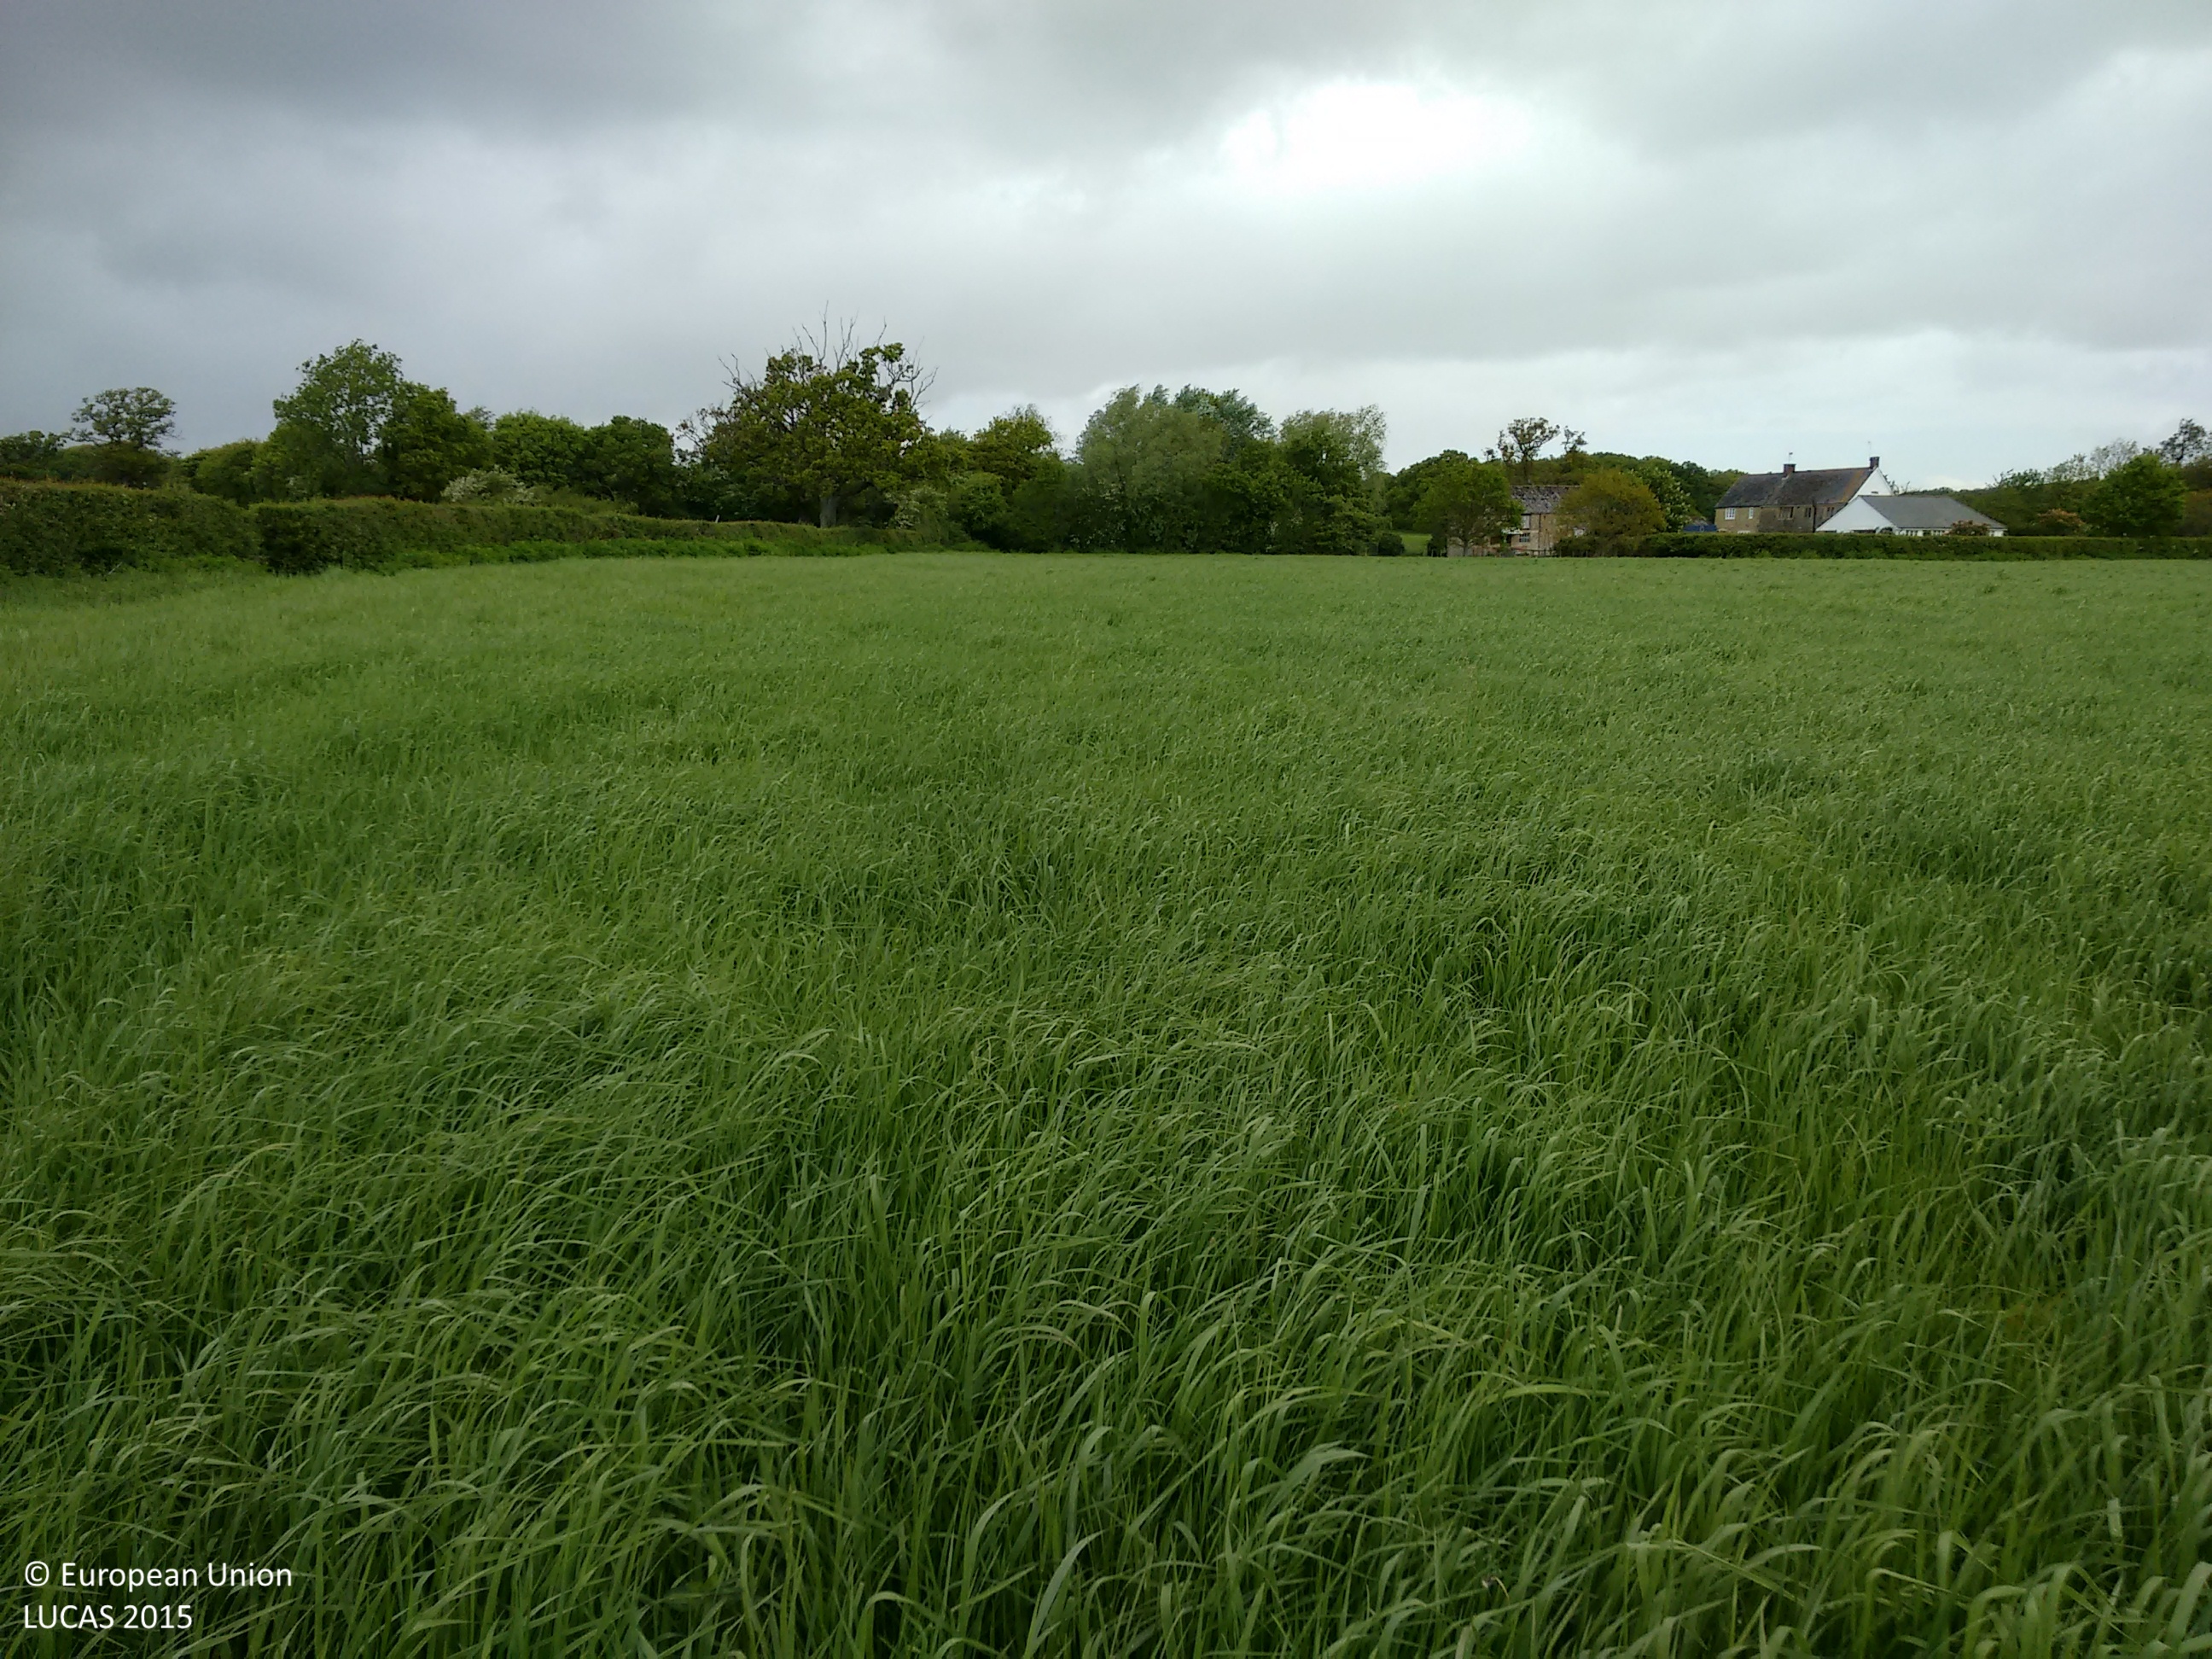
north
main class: Cropland
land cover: Temporary grasslands
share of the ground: > 75 %
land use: Agriculture (excluding fallow land and kitchen gardens)
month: May
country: GB
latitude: 50.9060
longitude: -2.3940
